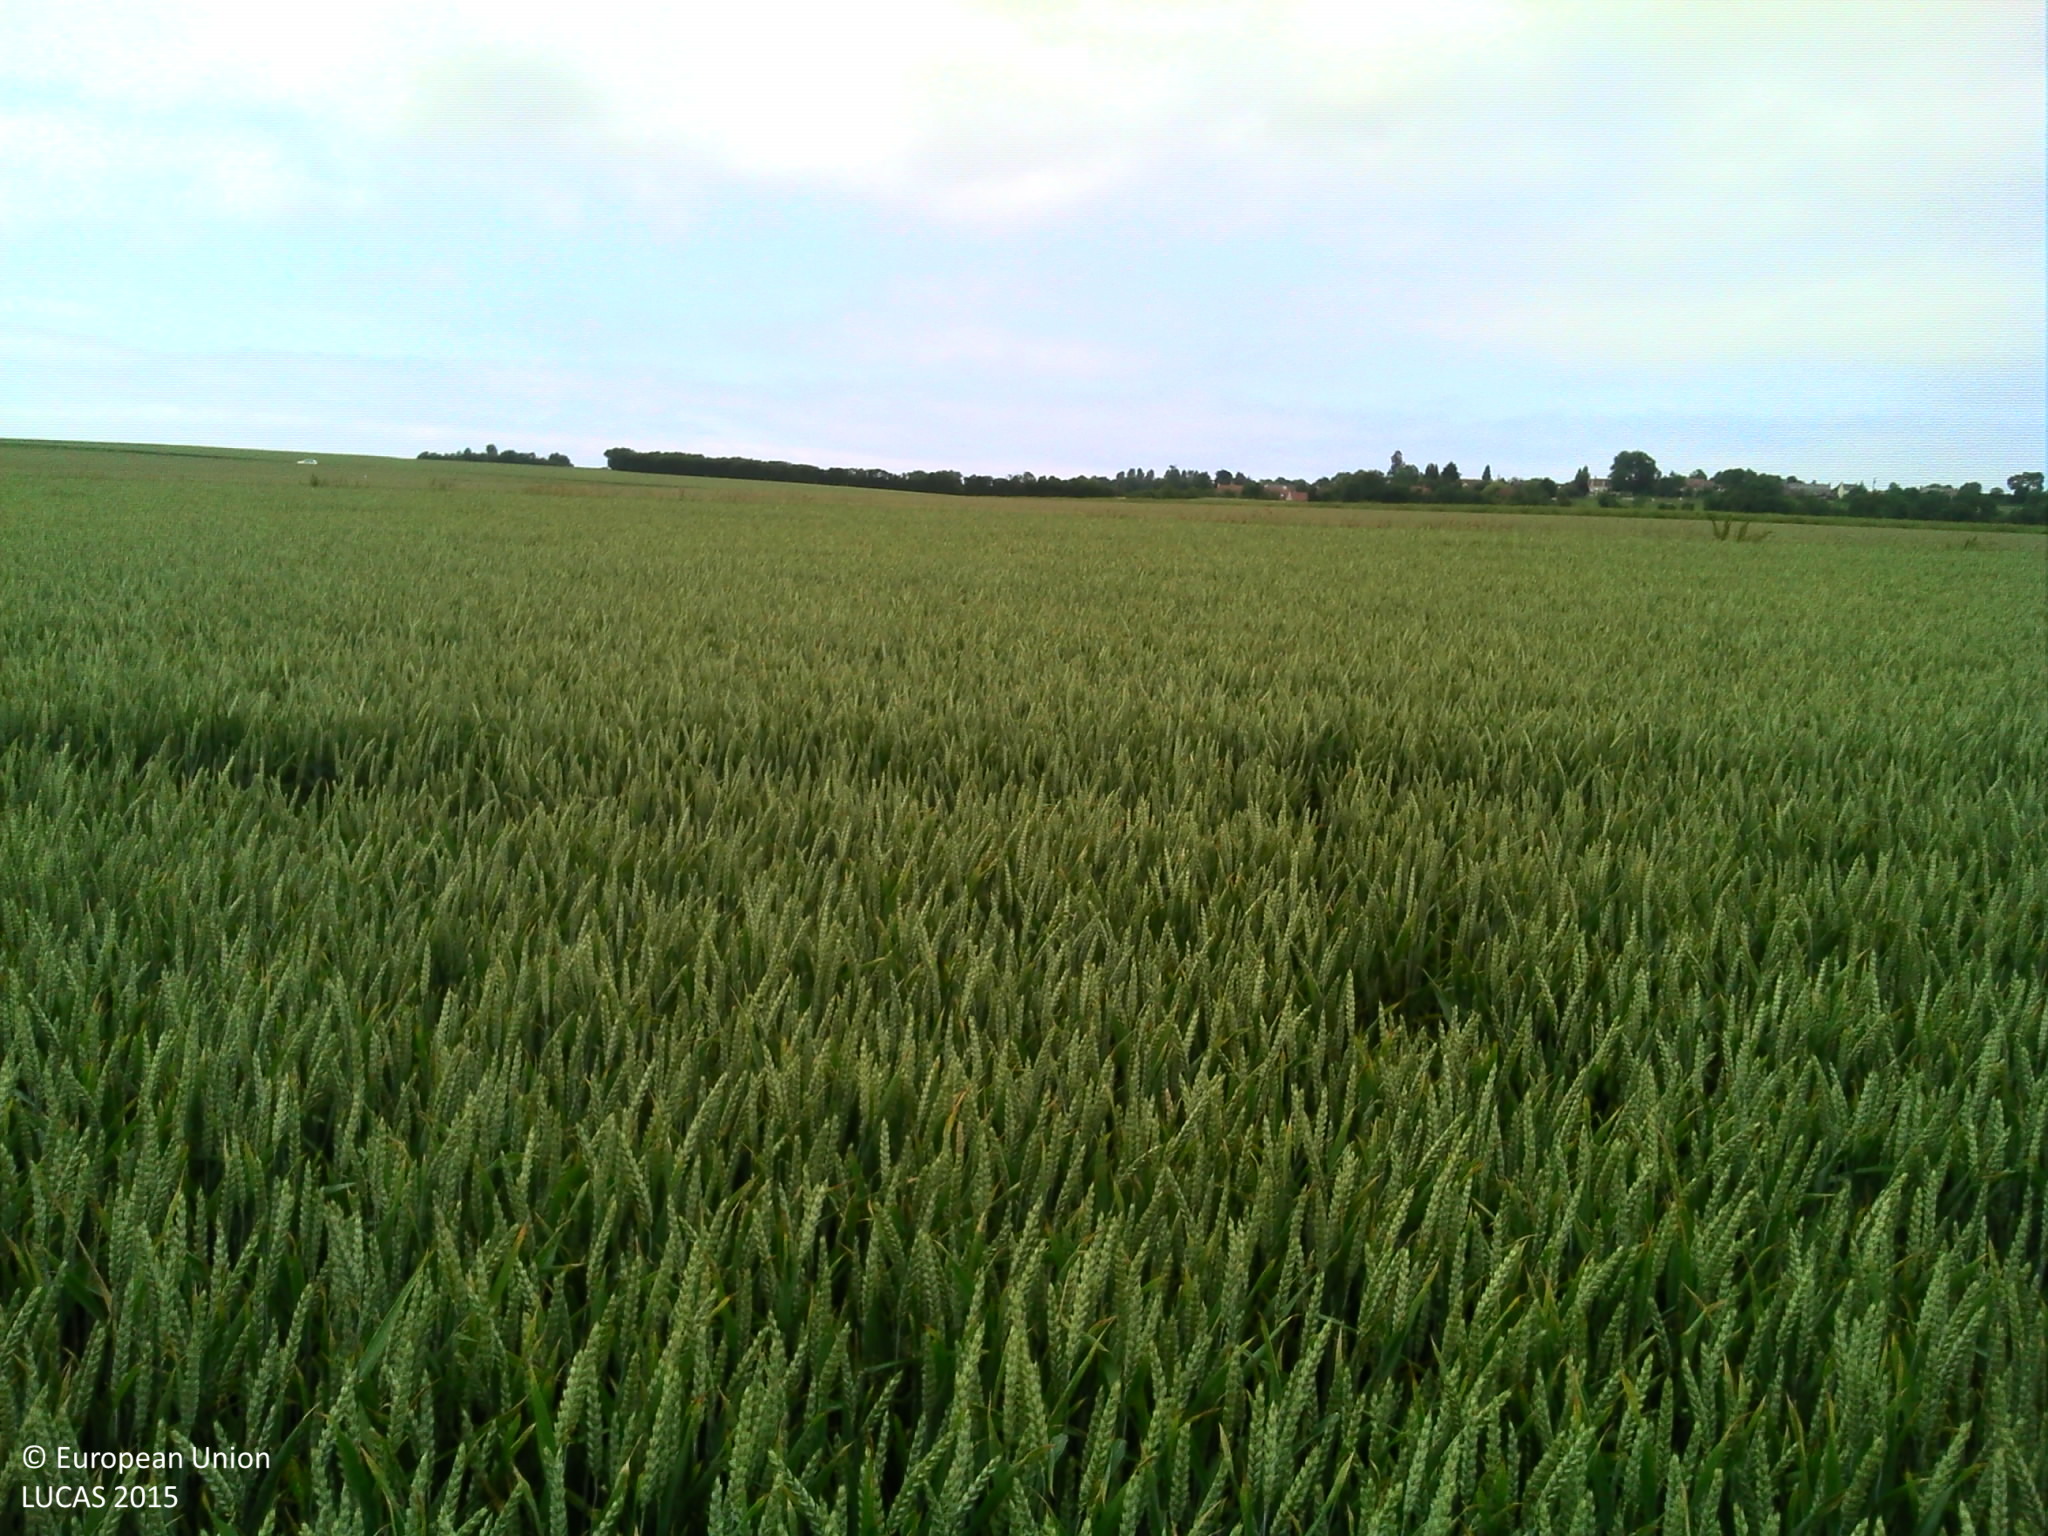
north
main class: Cropland
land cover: Common wheat
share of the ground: > 75 %
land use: Agriculture (excluding fallow land and kitchen gardens)
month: June
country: FR
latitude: 49.2327
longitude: -0.2373
